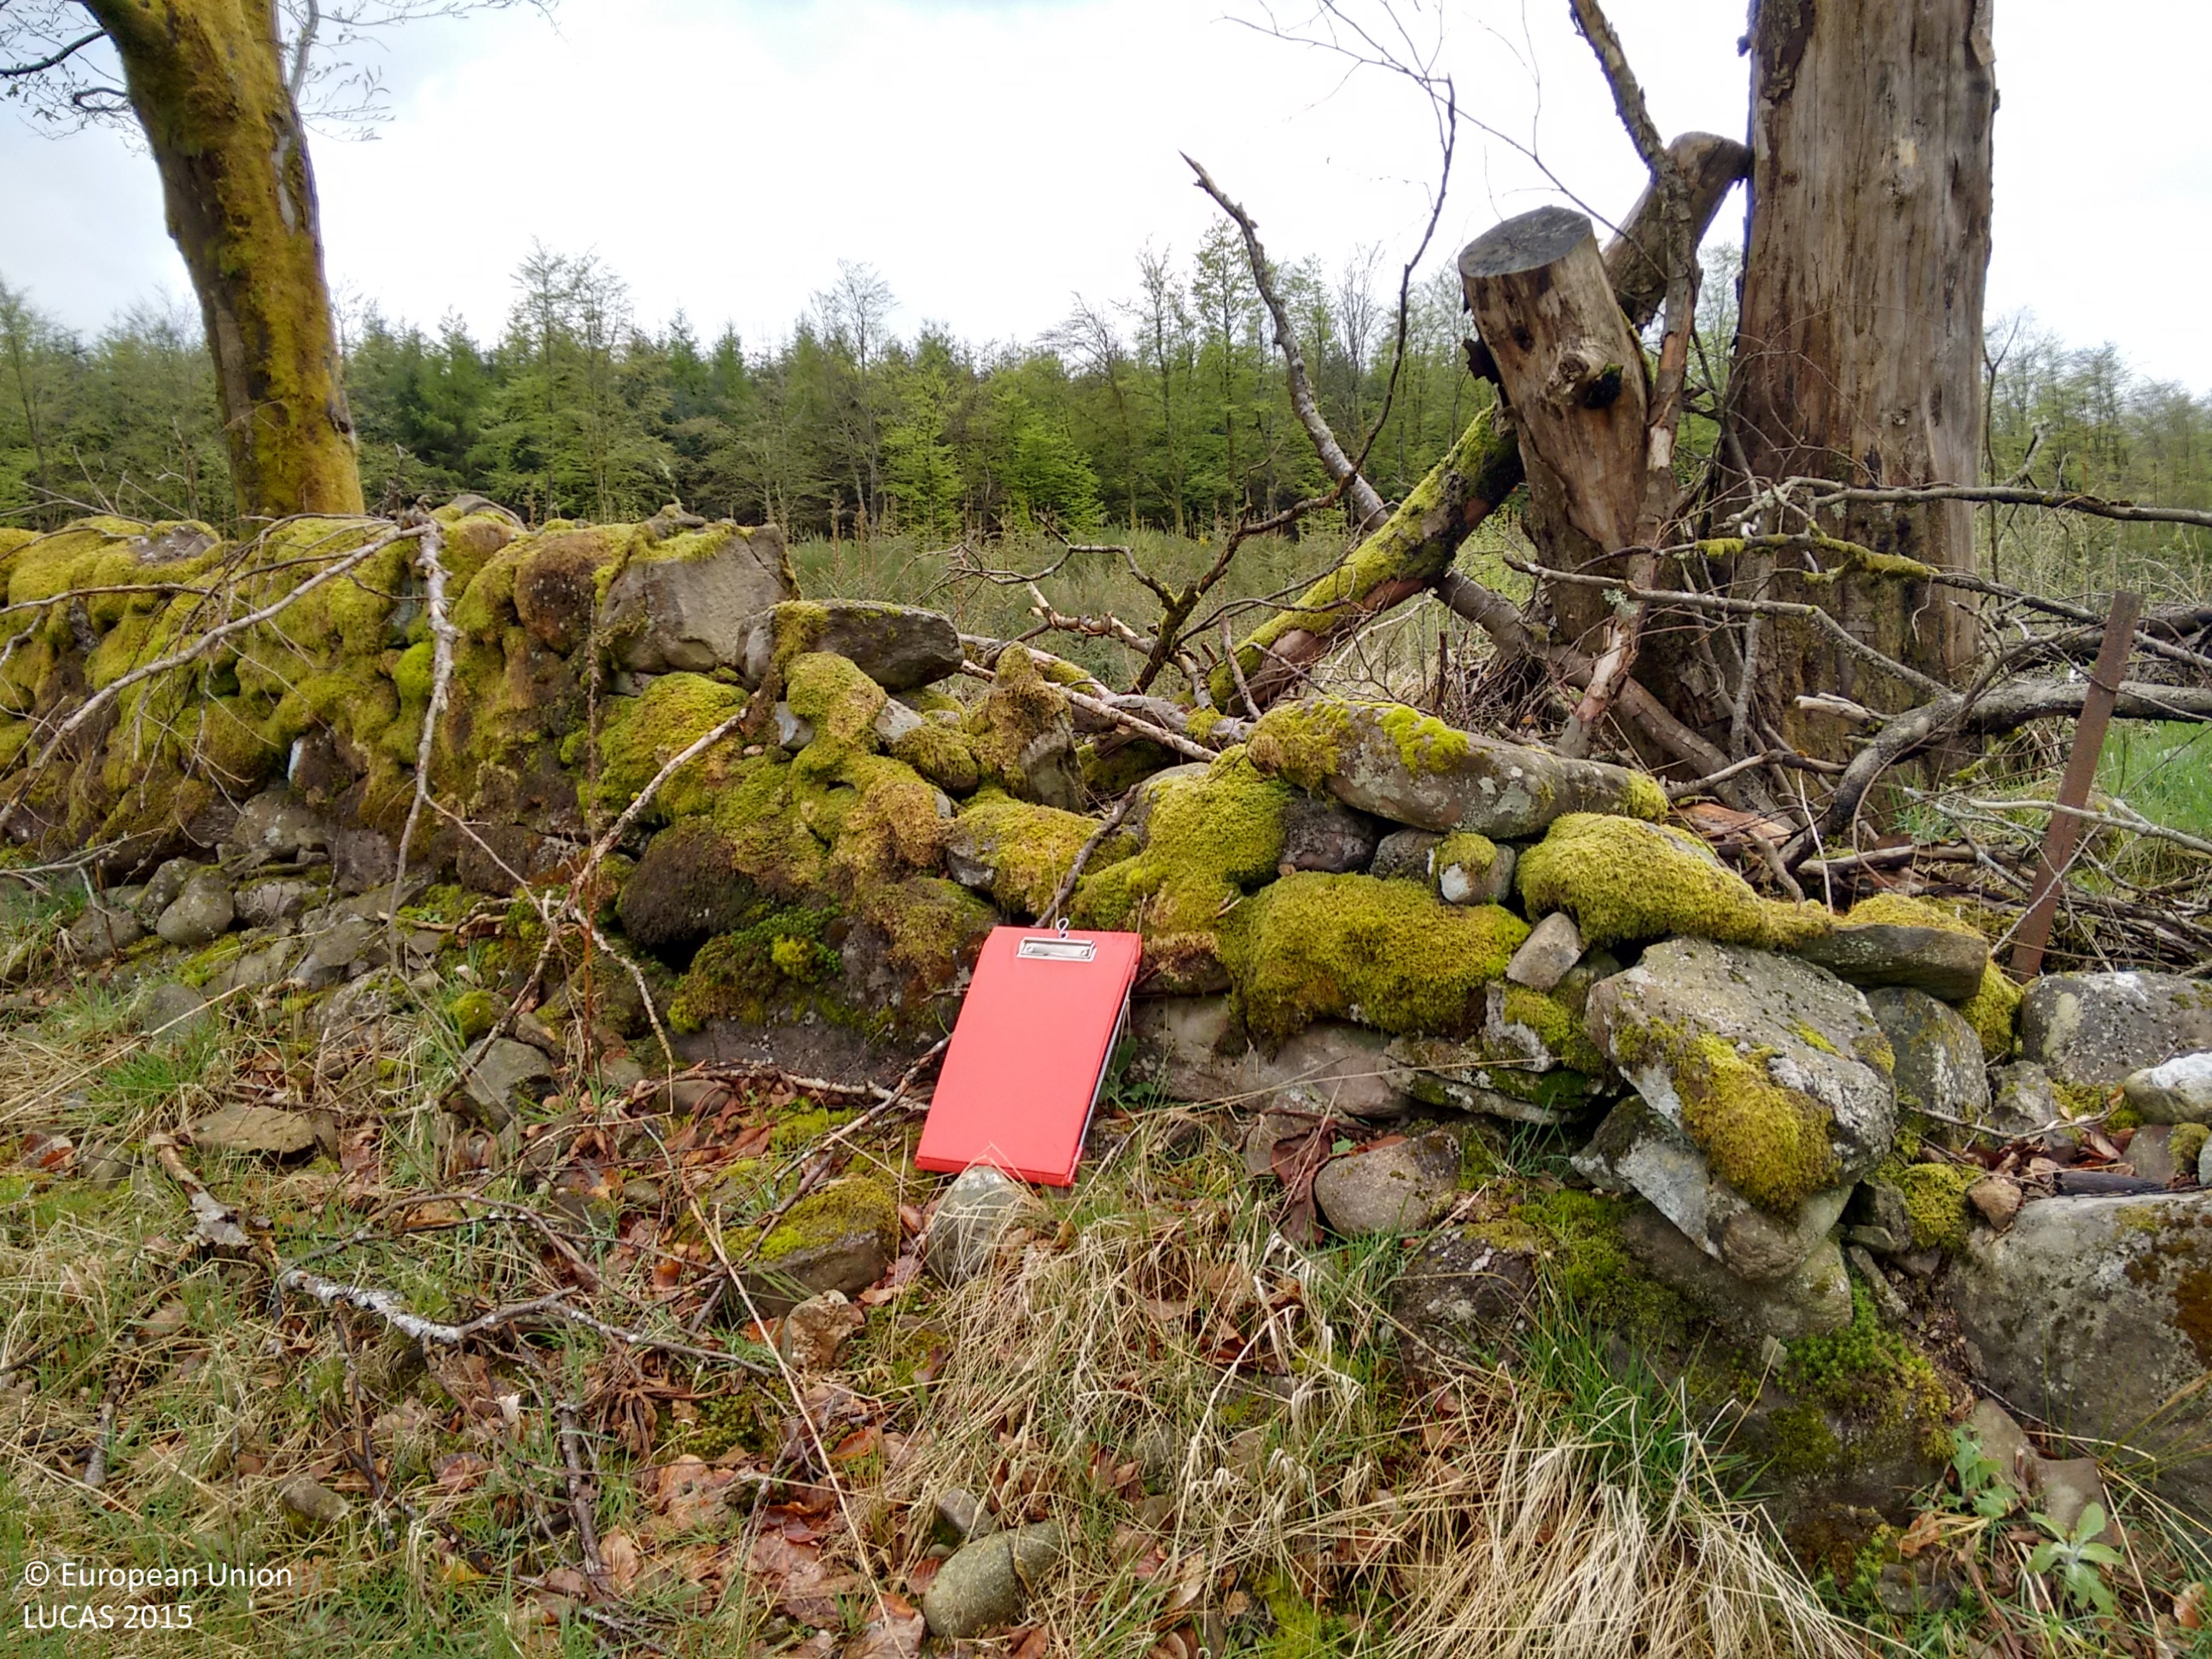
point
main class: Grassland
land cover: Grassland without tree/shrub cover
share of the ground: > 75 %
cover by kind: herbaceous plants 100 %
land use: Agriculture (excluding fallow land and kitchen gardens)
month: May
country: GB
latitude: 56.2086
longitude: -4.0983
